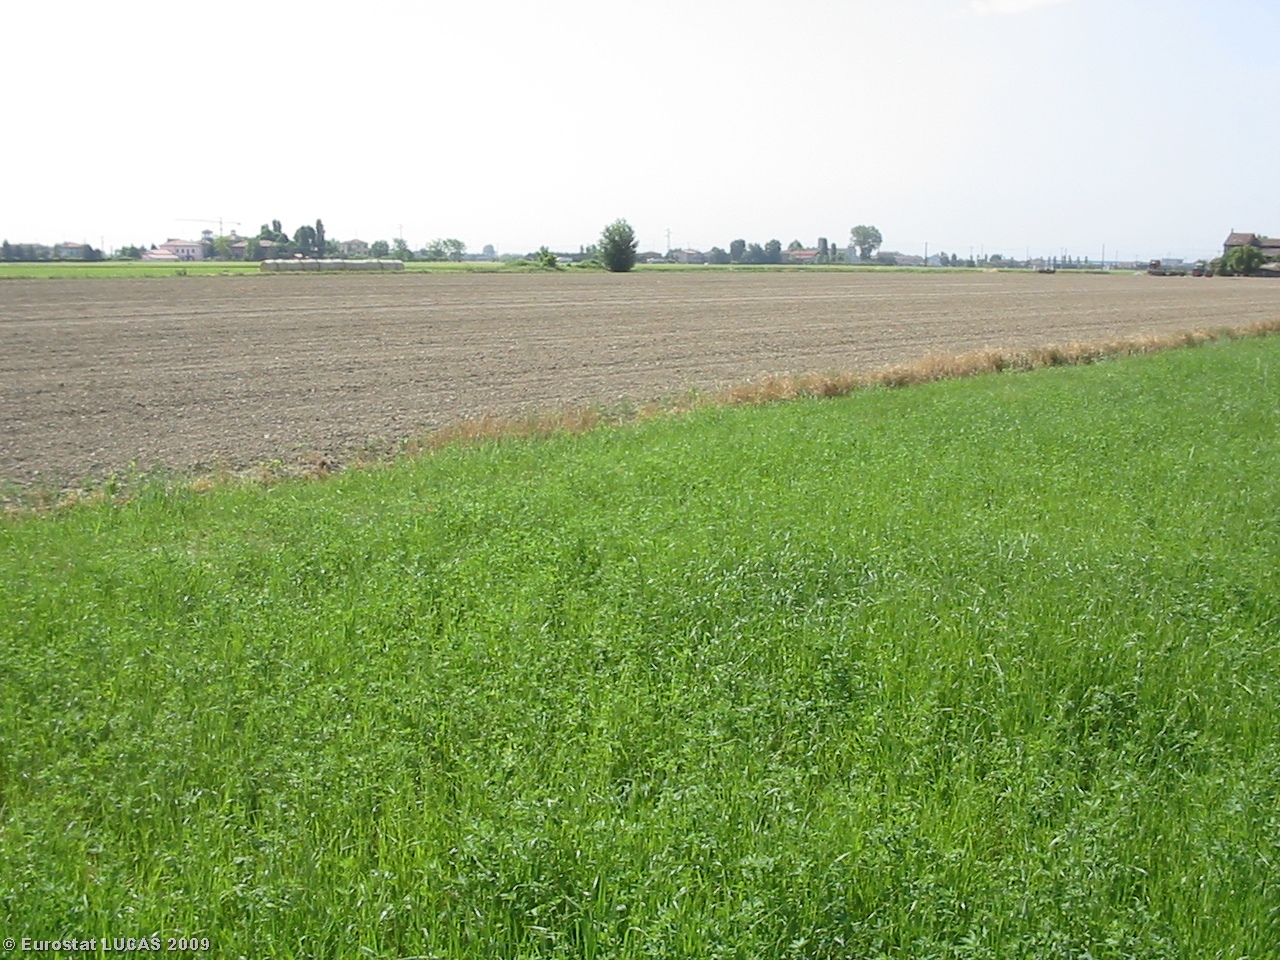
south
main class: Cropland
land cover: Lucerne
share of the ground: > 75 %
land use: Agriculture (excluding fallow land and kitchen gardens)
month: May
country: IT
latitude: 44.8730
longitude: 10.3411
